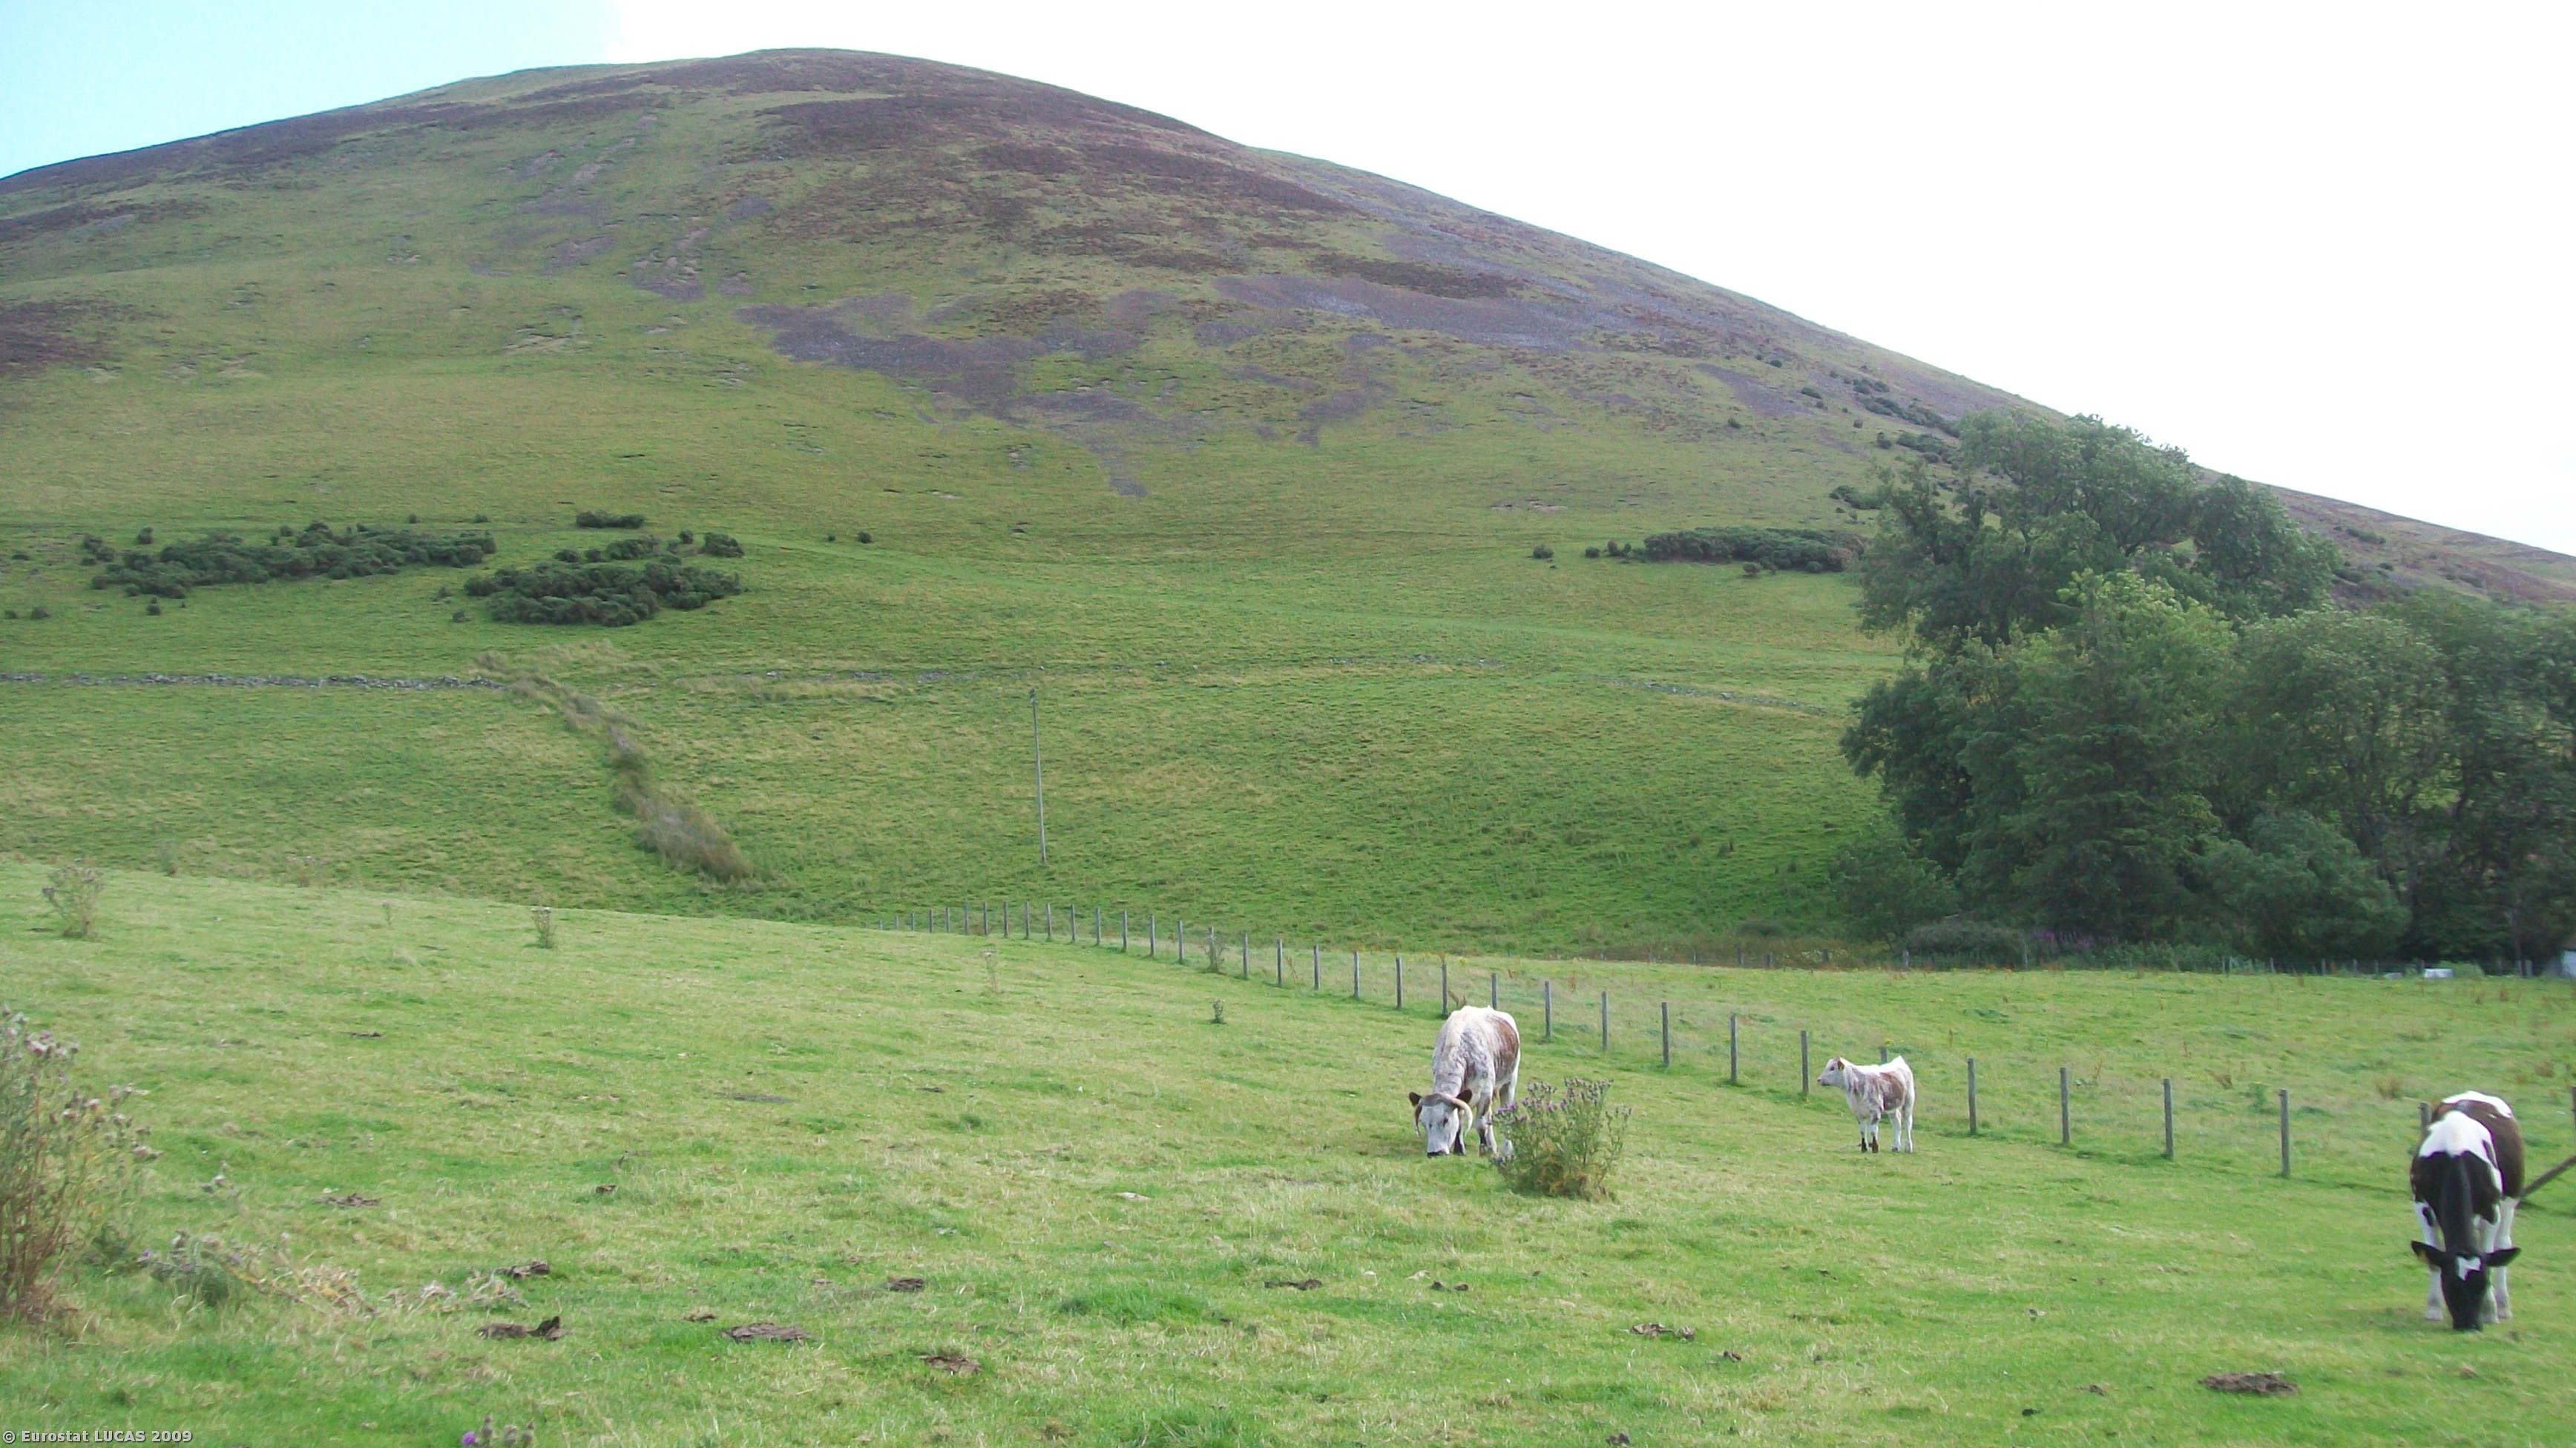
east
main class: Grassland
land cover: Grassland without tree/shrub cover
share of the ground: > 75 %
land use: Agriculture (excluding fallow land and kitchen gardens)
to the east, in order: Grassland without tree/shrub cover; Fences; Grassland without tree/shrub cover; Fences; Grass margins; Rivers and streams; Grass margins; Fences; Grassland without tree/shrub cover; Electric lines; Grassland without tree/shrub cover; Dry stone walls; Grassland without tree/shrub cover; Single bushes/trees; Grassland without tree/shrub cover
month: August
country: GB
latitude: 55.5989
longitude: -3.4891
